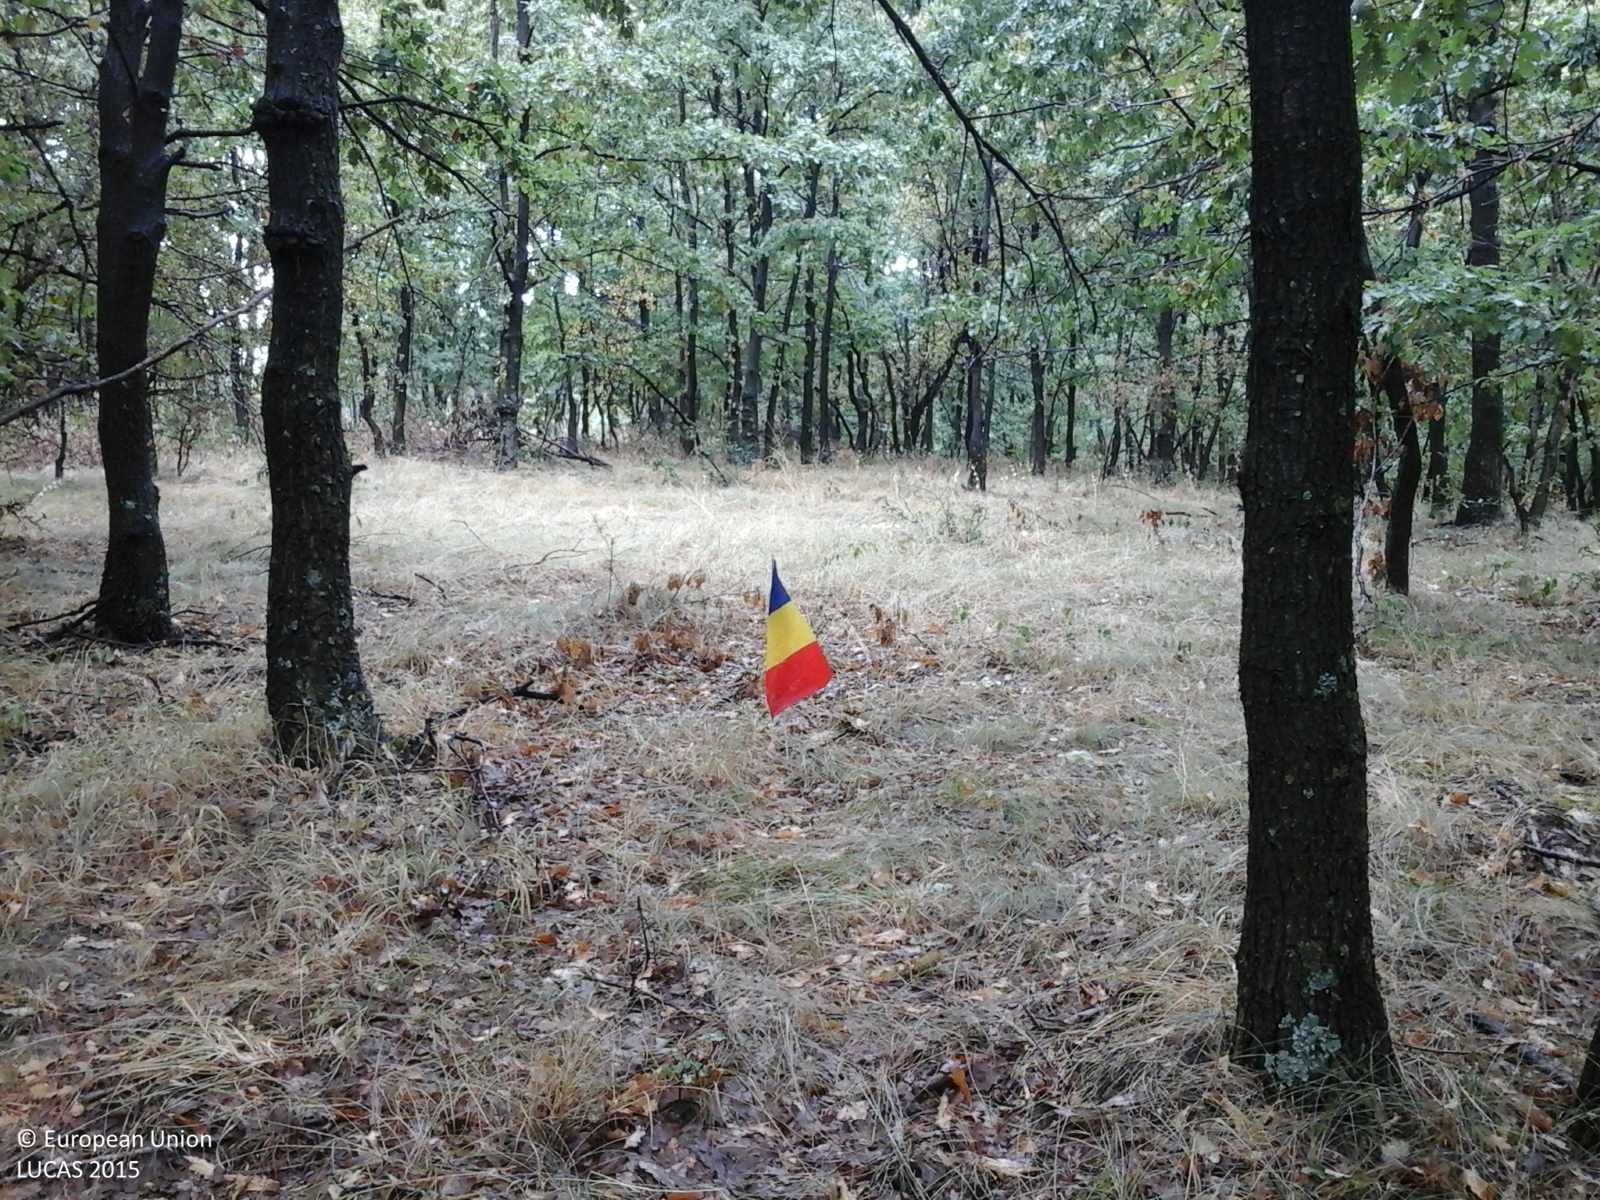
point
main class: Woodland
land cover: Broadleaved woodland
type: mesophytic deciduous forest
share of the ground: > 75 %
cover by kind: broadleaved forest trees 90 %, herbaceous plants 10 %
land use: Forestry
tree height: > 5 m
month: August
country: RO
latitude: 44.7156
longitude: 22.5506
